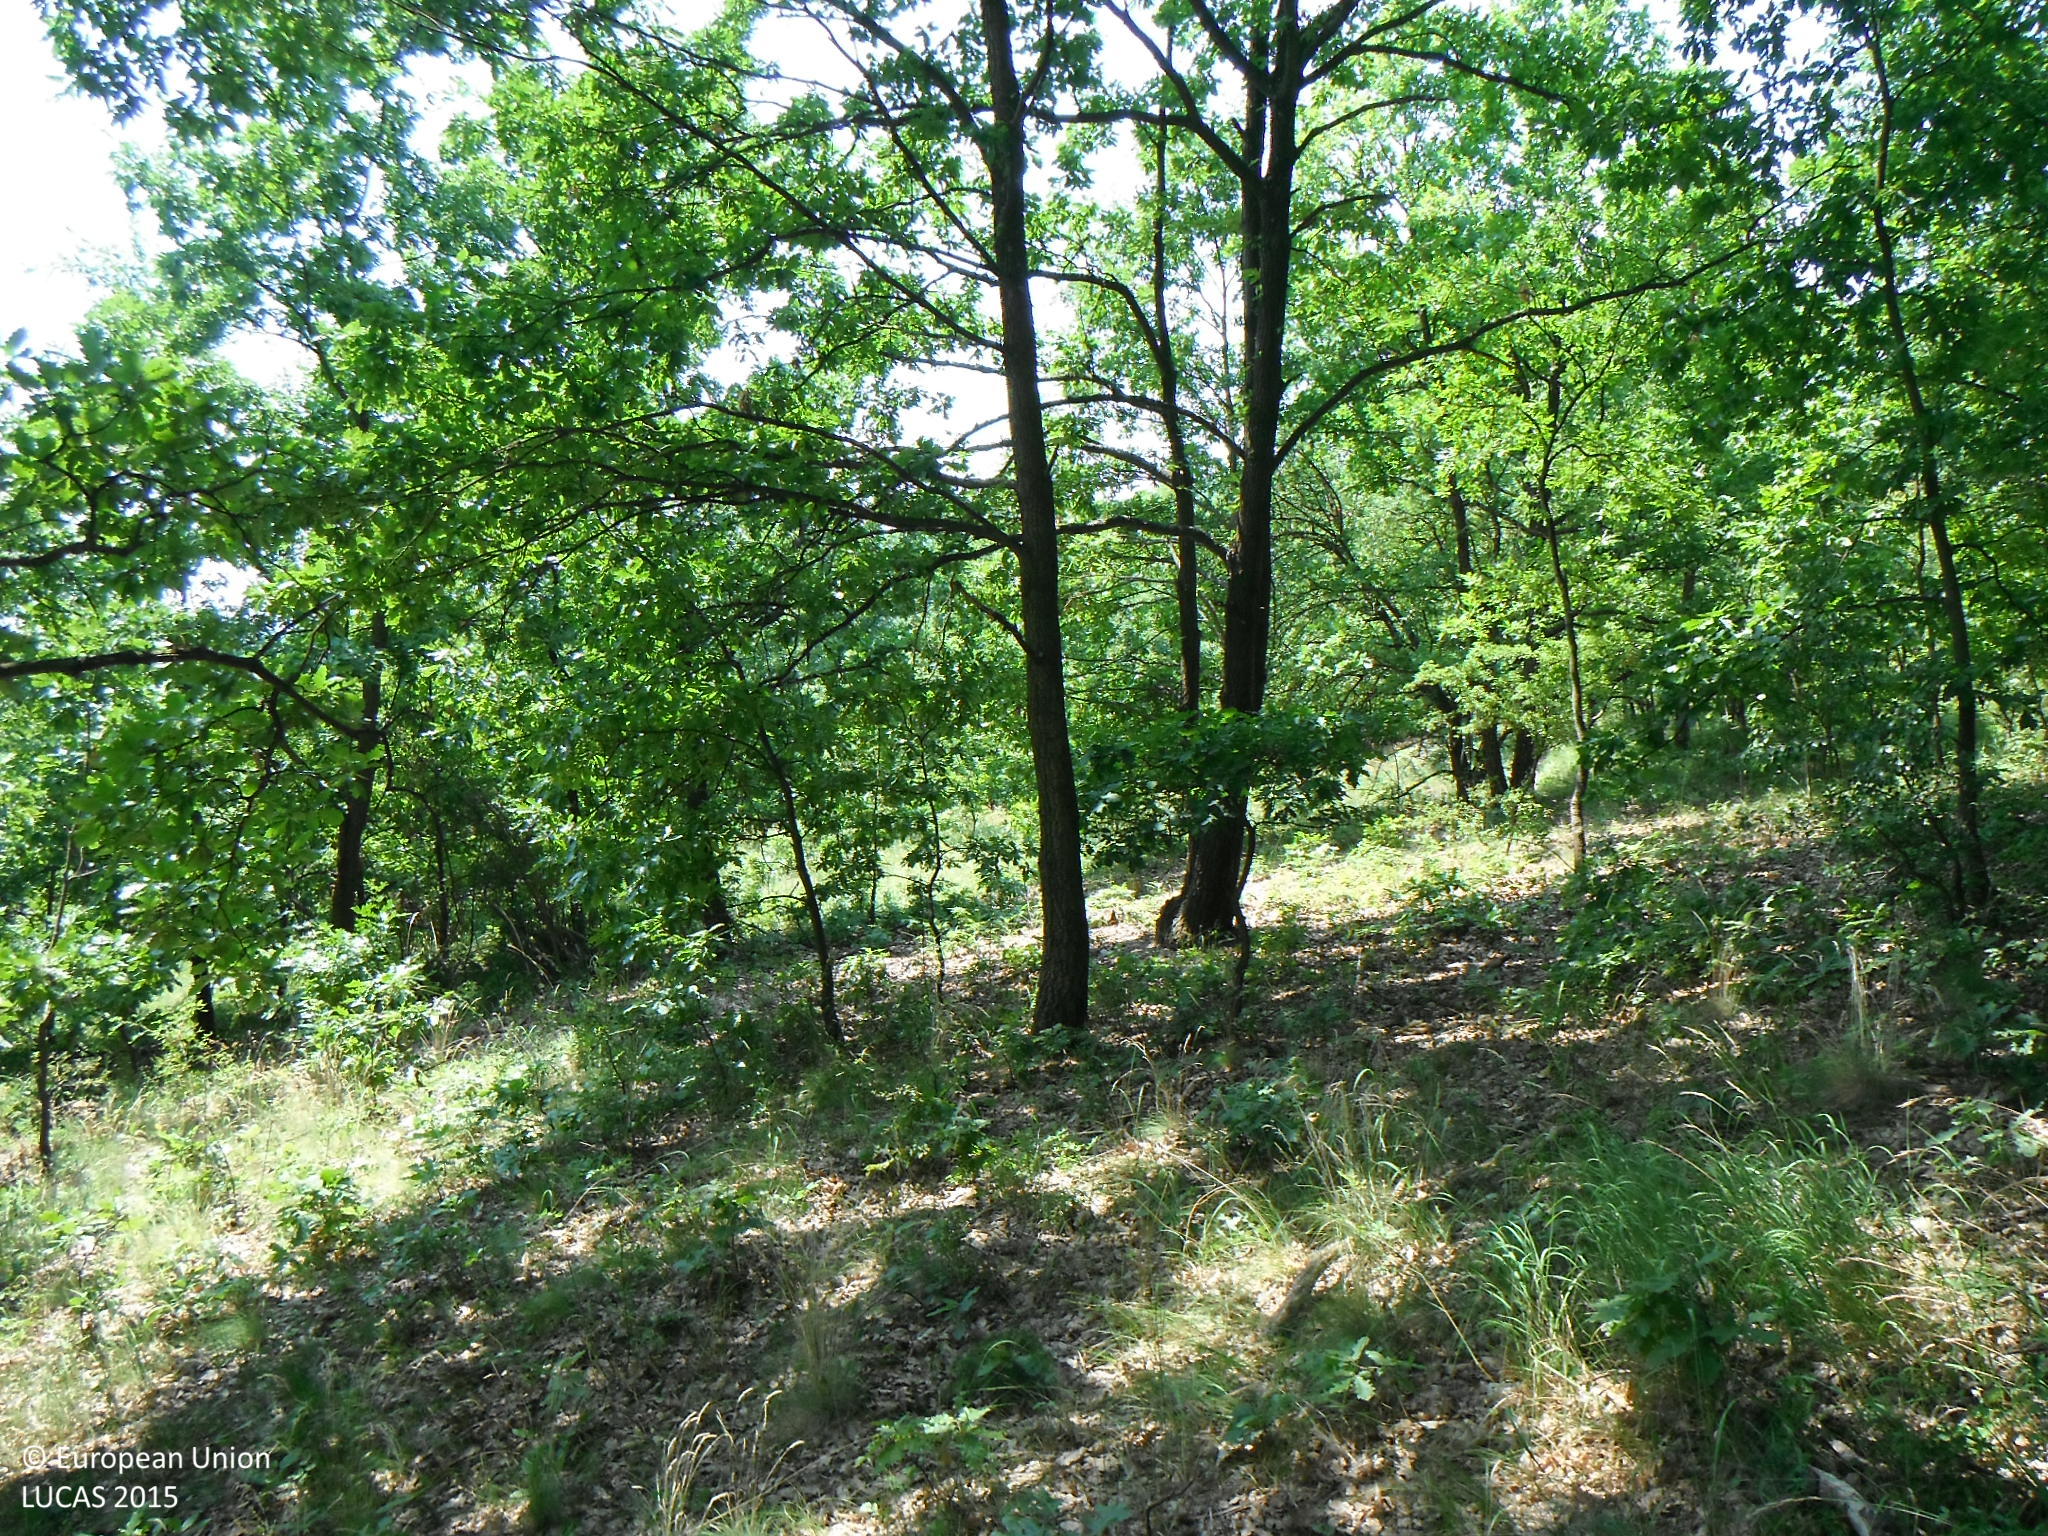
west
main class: Woodland
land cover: Broadleaved woodland
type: acidophilous oak and oak-birch forest
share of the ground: > 75 %
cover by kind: broadleaved forest trees 75 %, herbaceous plants 20 %, shrubs 5 %
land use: Forestry
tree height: > 5 m
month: July
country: SK
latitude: 48.0879
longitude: 19.0281
